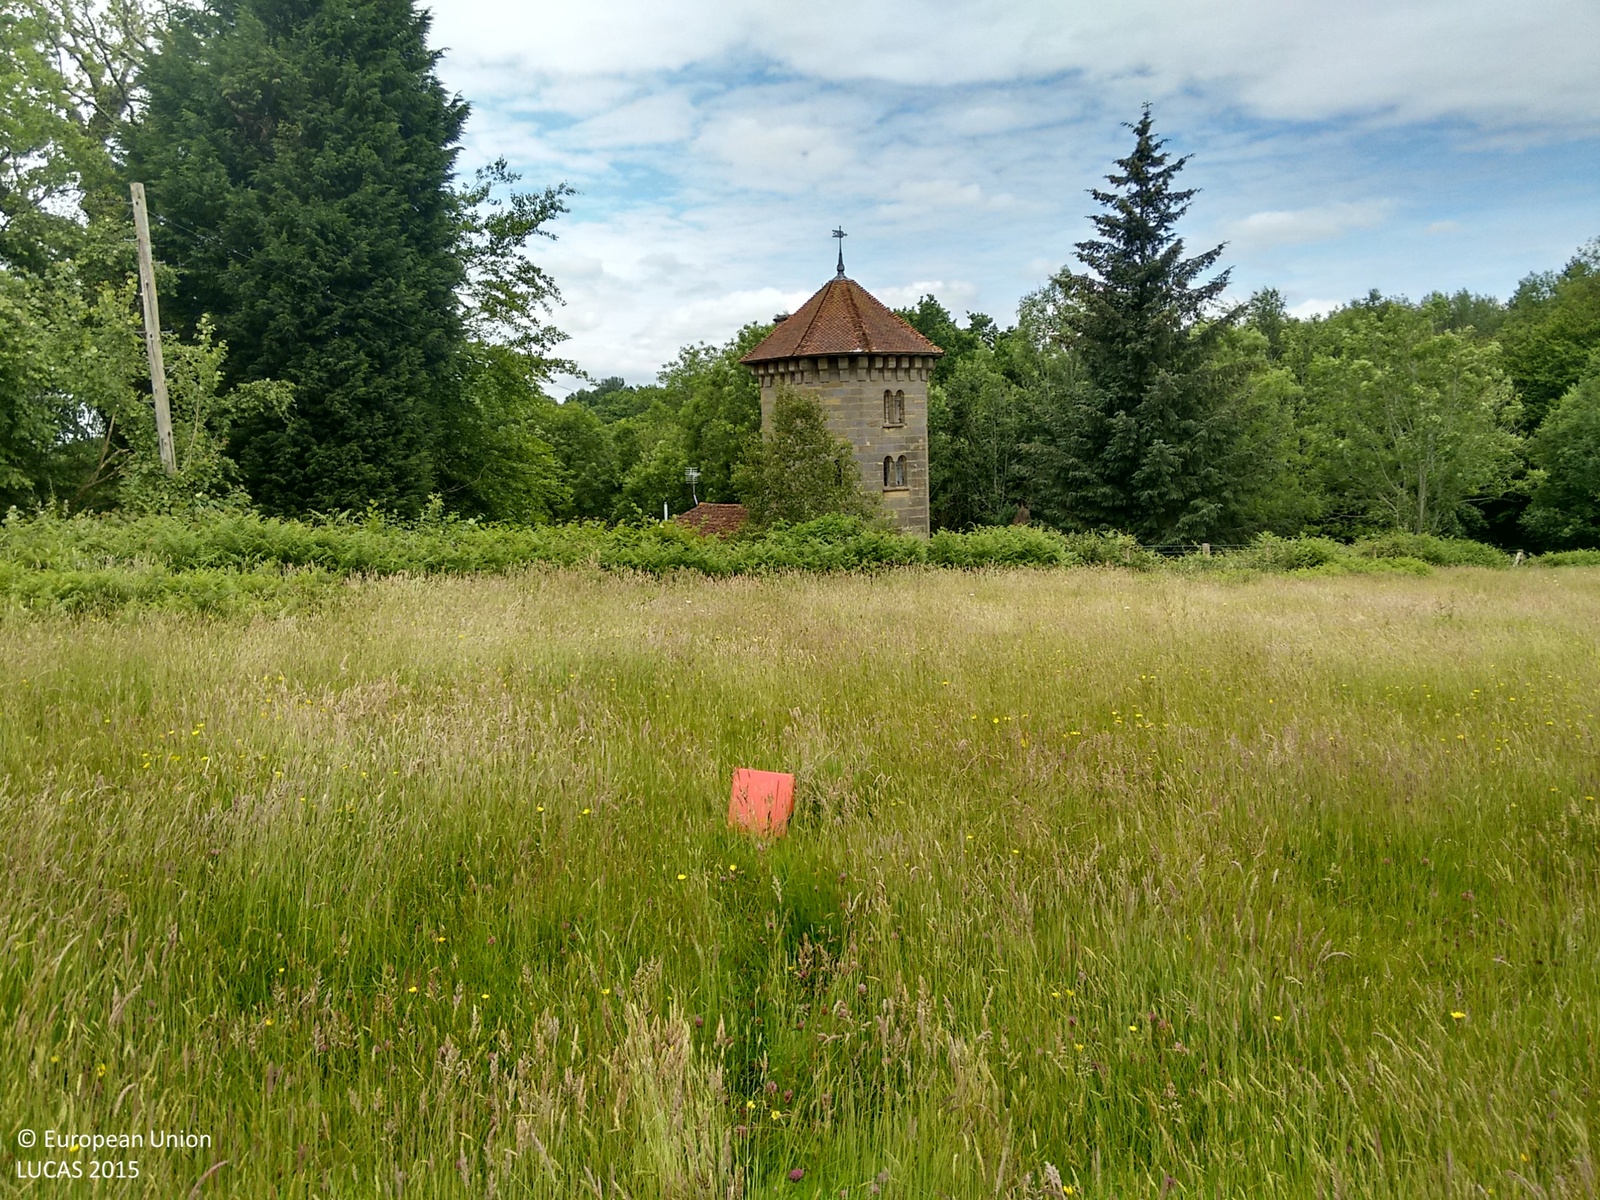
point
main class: Grassland
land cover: Grassland without tree/shrub cover
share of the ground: > 75 %
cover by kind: herbaceous plants 100 %
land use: Agriculture (excluding fallow land and kitchen gardens)
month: June
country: GB
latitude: 50.9214
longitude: 0.4261
